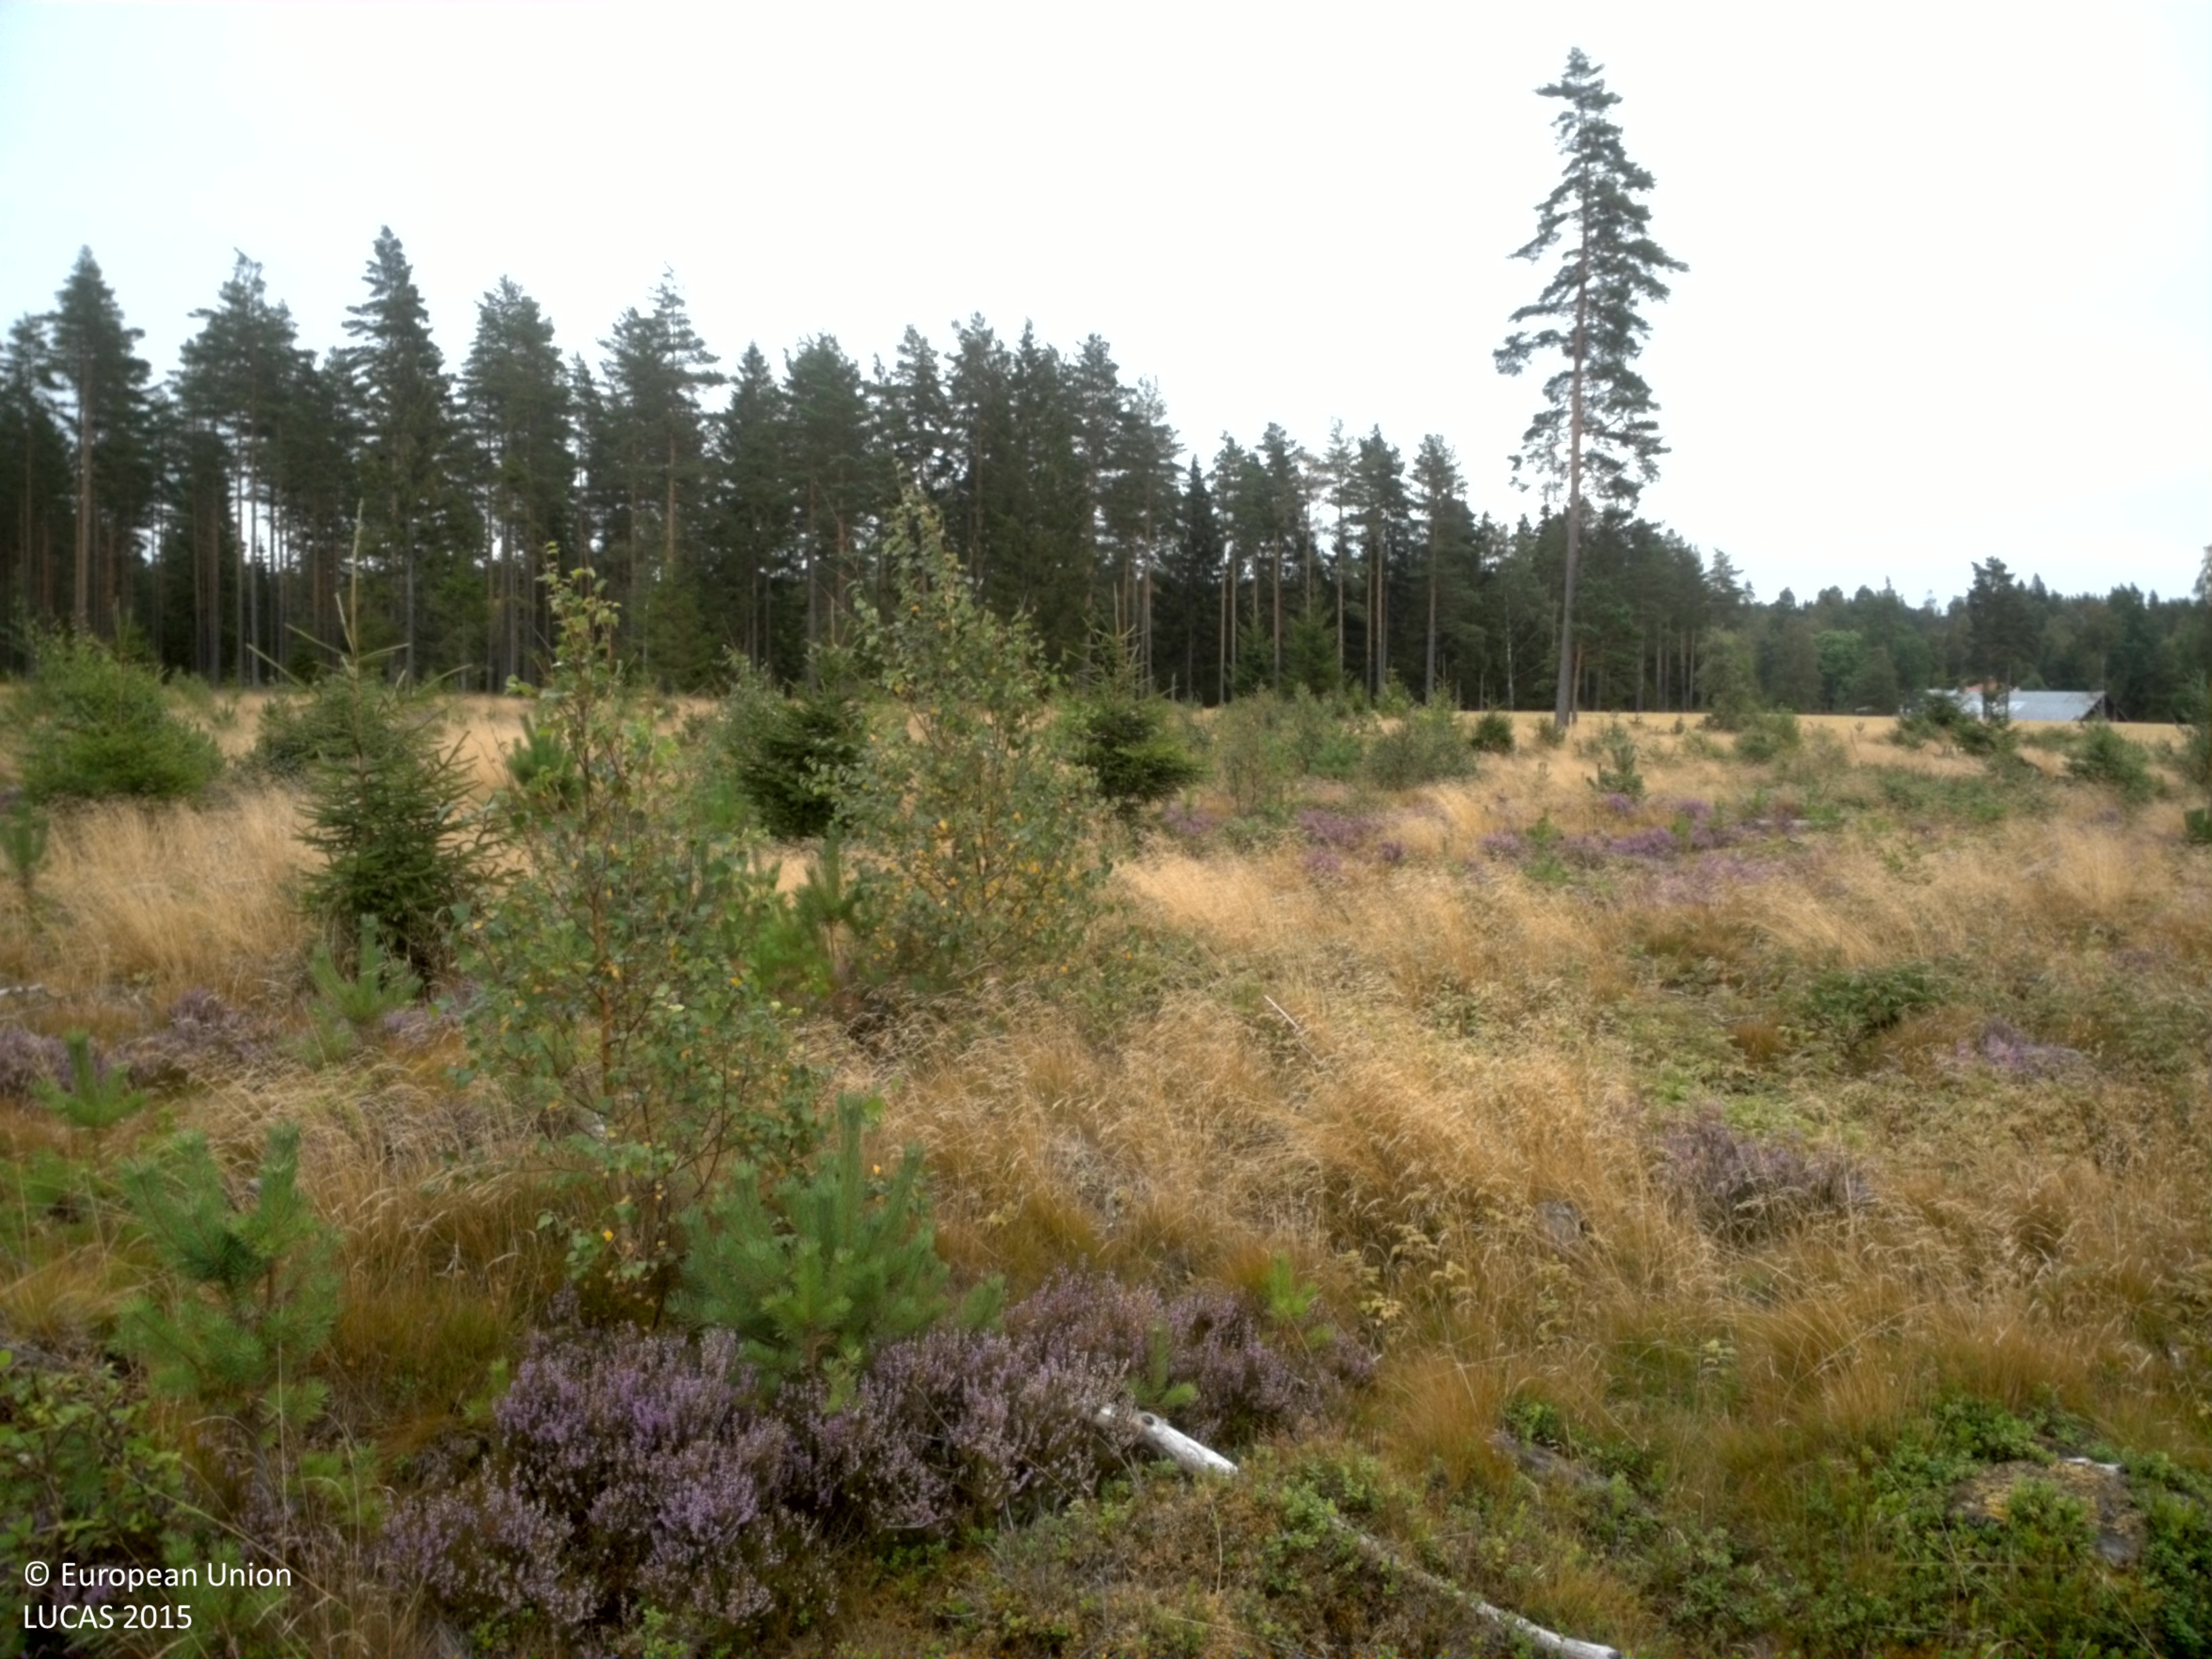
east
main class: Woodland
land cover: Pine dominated mixed woodland
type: boreal forest
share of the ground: 10 - 25 %
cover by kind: herbaceous plants 60 %, coniferous forest trees 15 %, shrubs 15 %, broadleaved forest trees 10 %
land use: Forestry
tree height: < 5 m
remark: Clear cut
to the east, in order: Pine dominated mixed woodland; Pine dominated coniferous woodland; Tracks; Pine dominated coniferous woodland; Other mixed woodland; Pine dominated coniferous woodland; Spruce dominated mixed woodland; Ditches and canals
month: August
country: SE
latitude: 57.8751
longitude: 13.8896
